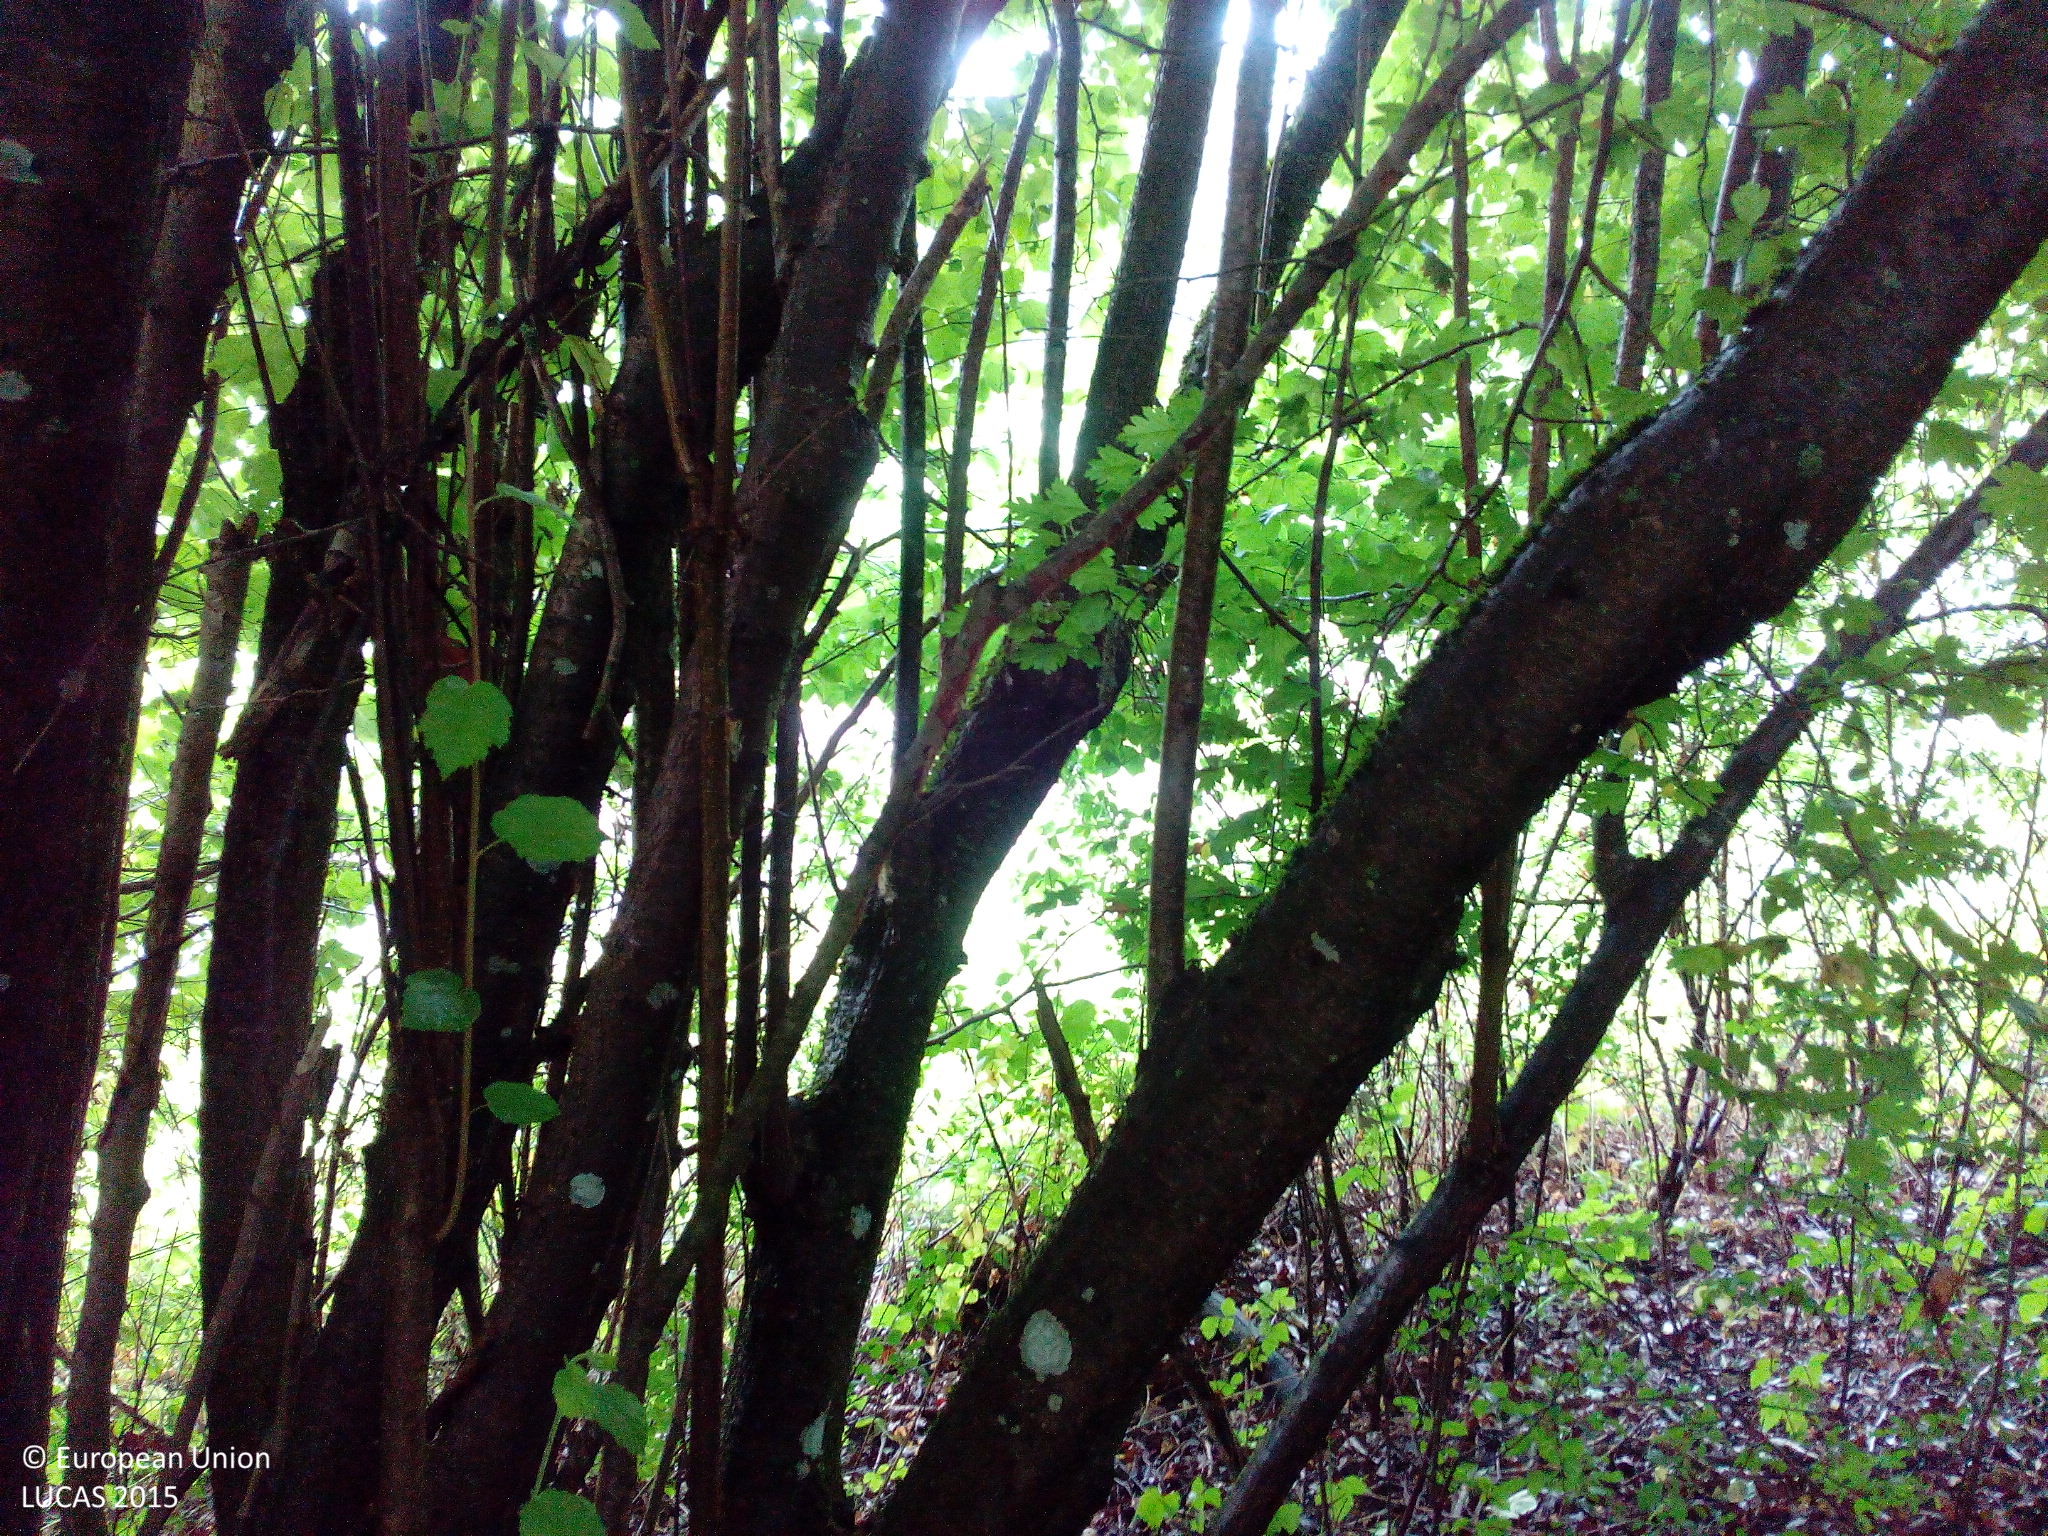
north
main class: Woodland
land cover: Broadleaved woodland
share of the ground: > 75 %
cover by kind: broadleaved forest trees 90 %, shrubs 10 %
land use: Semi-natural and natural areas not in use
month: July
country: DE
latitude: 49.0147
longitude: 9.6857
